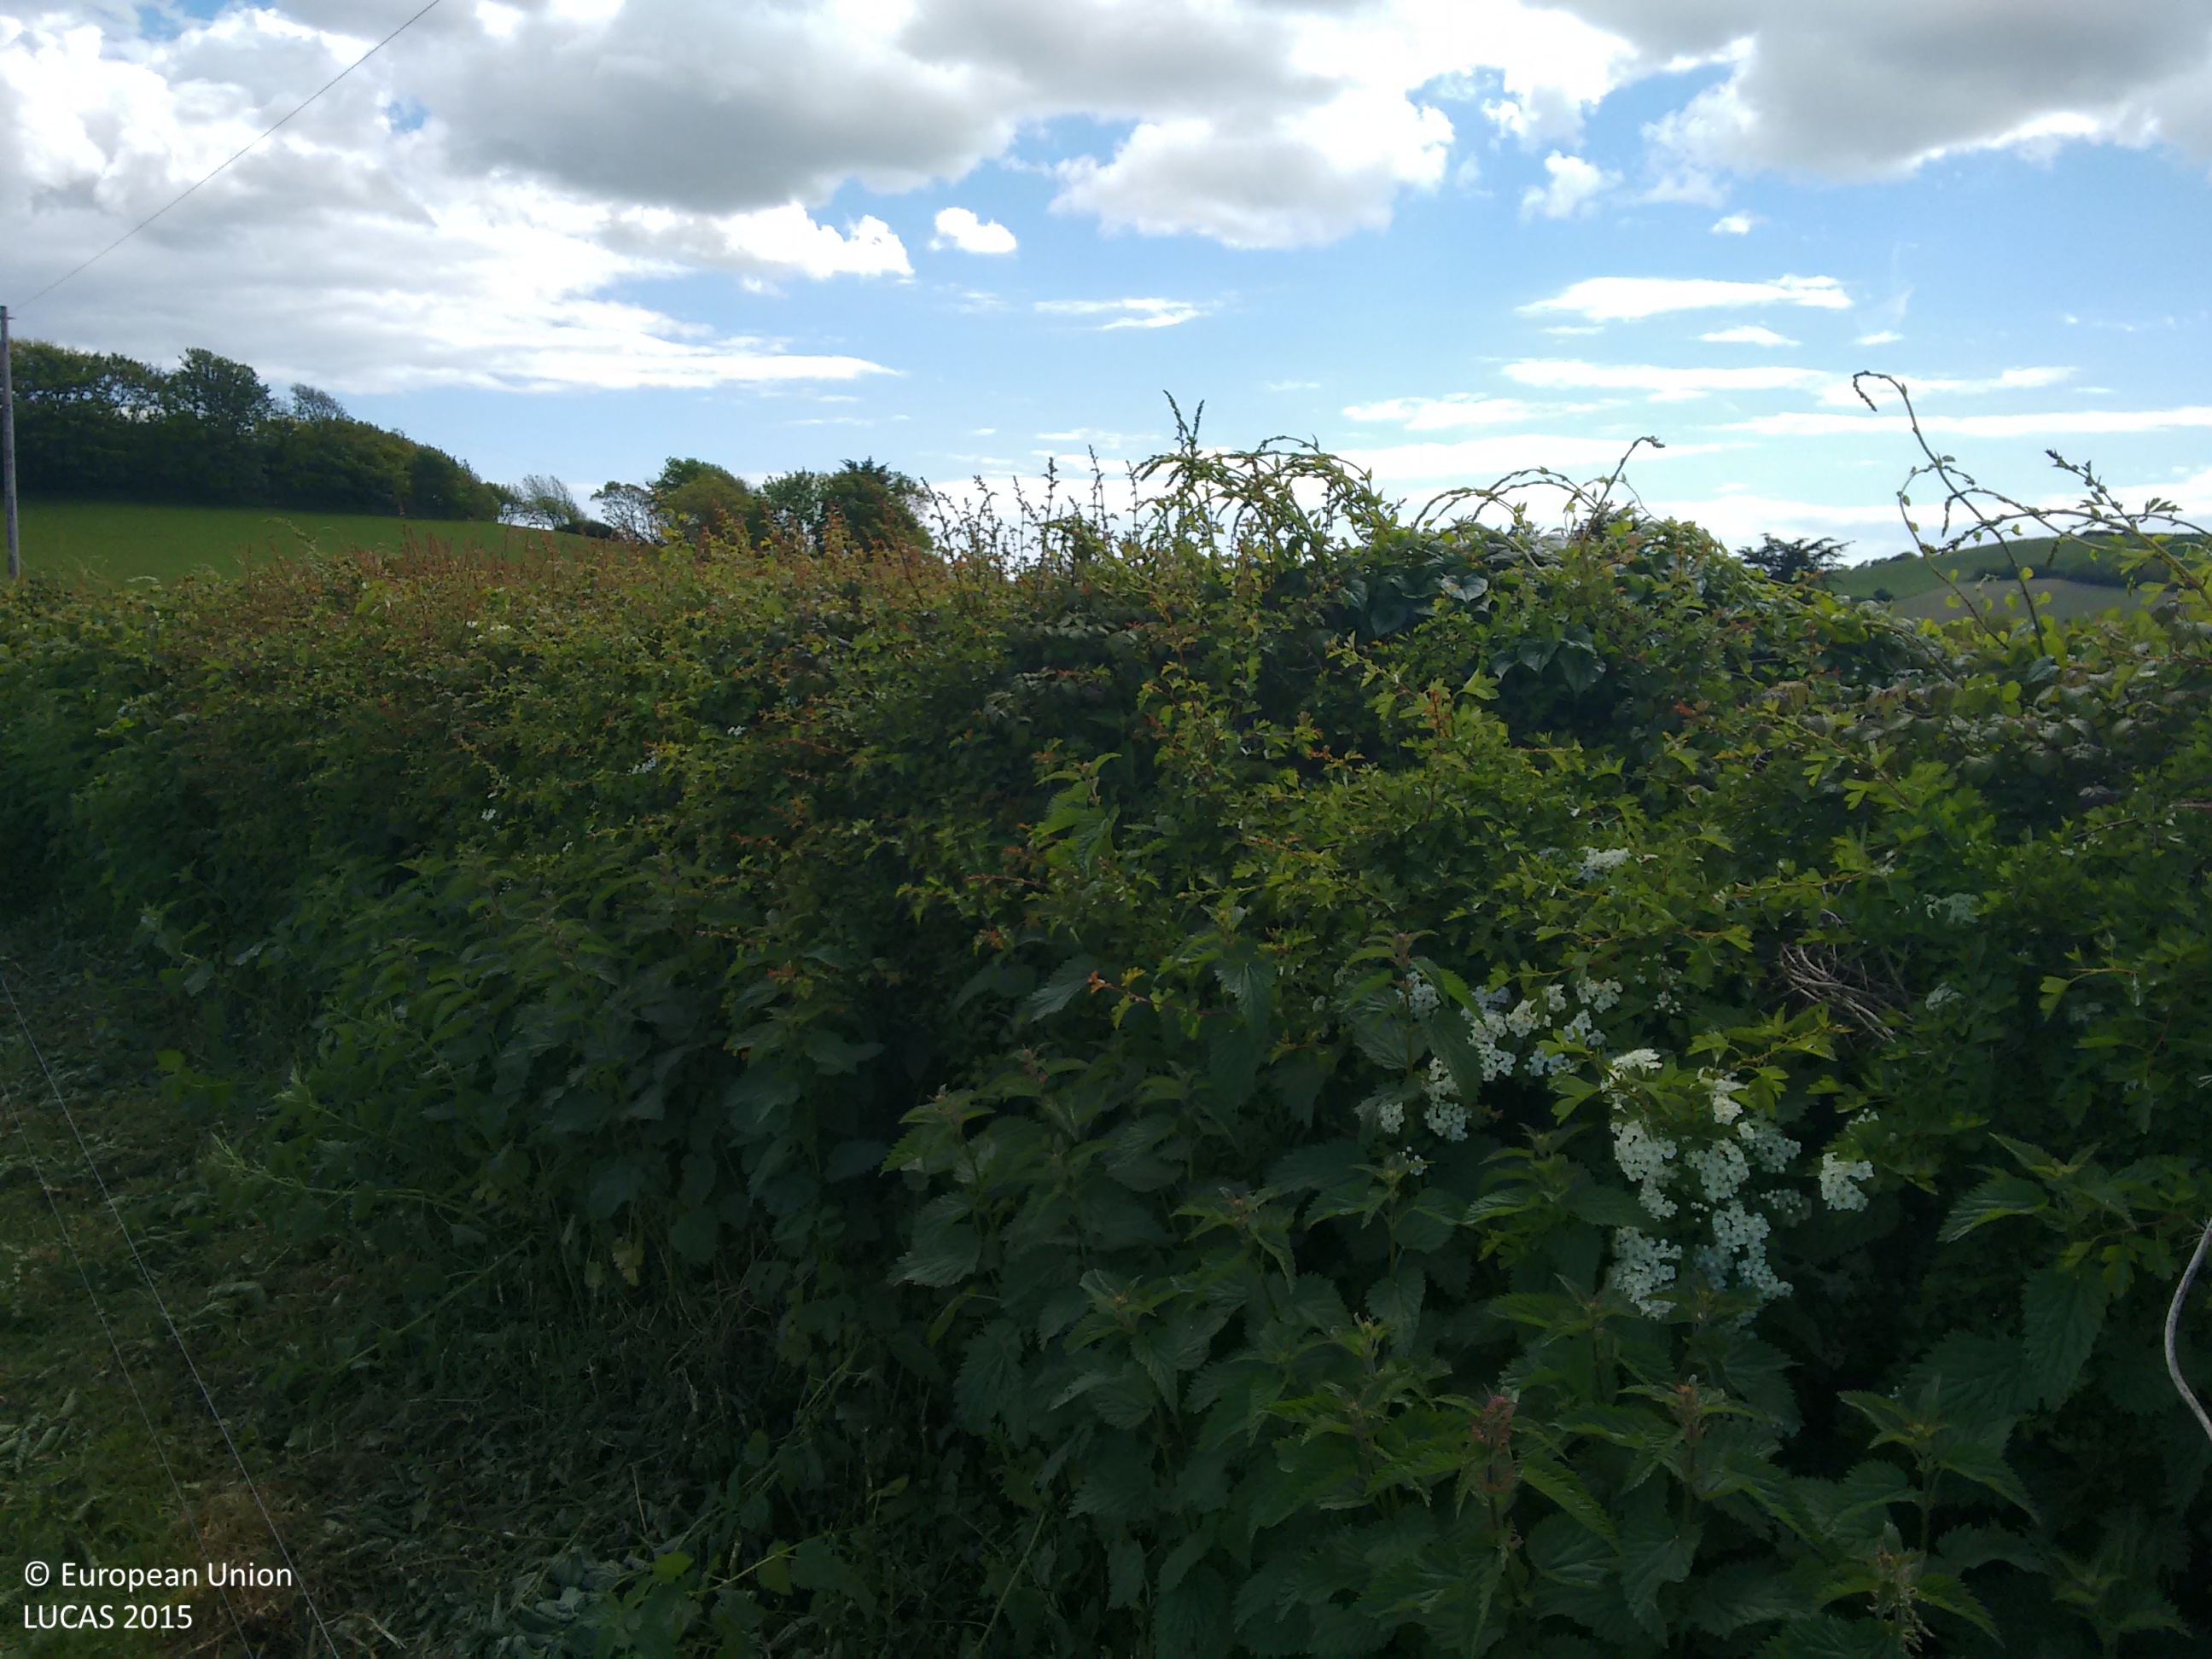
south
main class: Grassland
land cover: Grassland without tree/shrub cover
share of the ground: > 75 %
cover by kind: herbaceous plants 75 %, unconsolidated bare surface 25 %
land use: Agriculture (excluding fallow land and kitchen gardens)
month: May
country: GB
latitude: 50.6562
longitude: -1.2934
